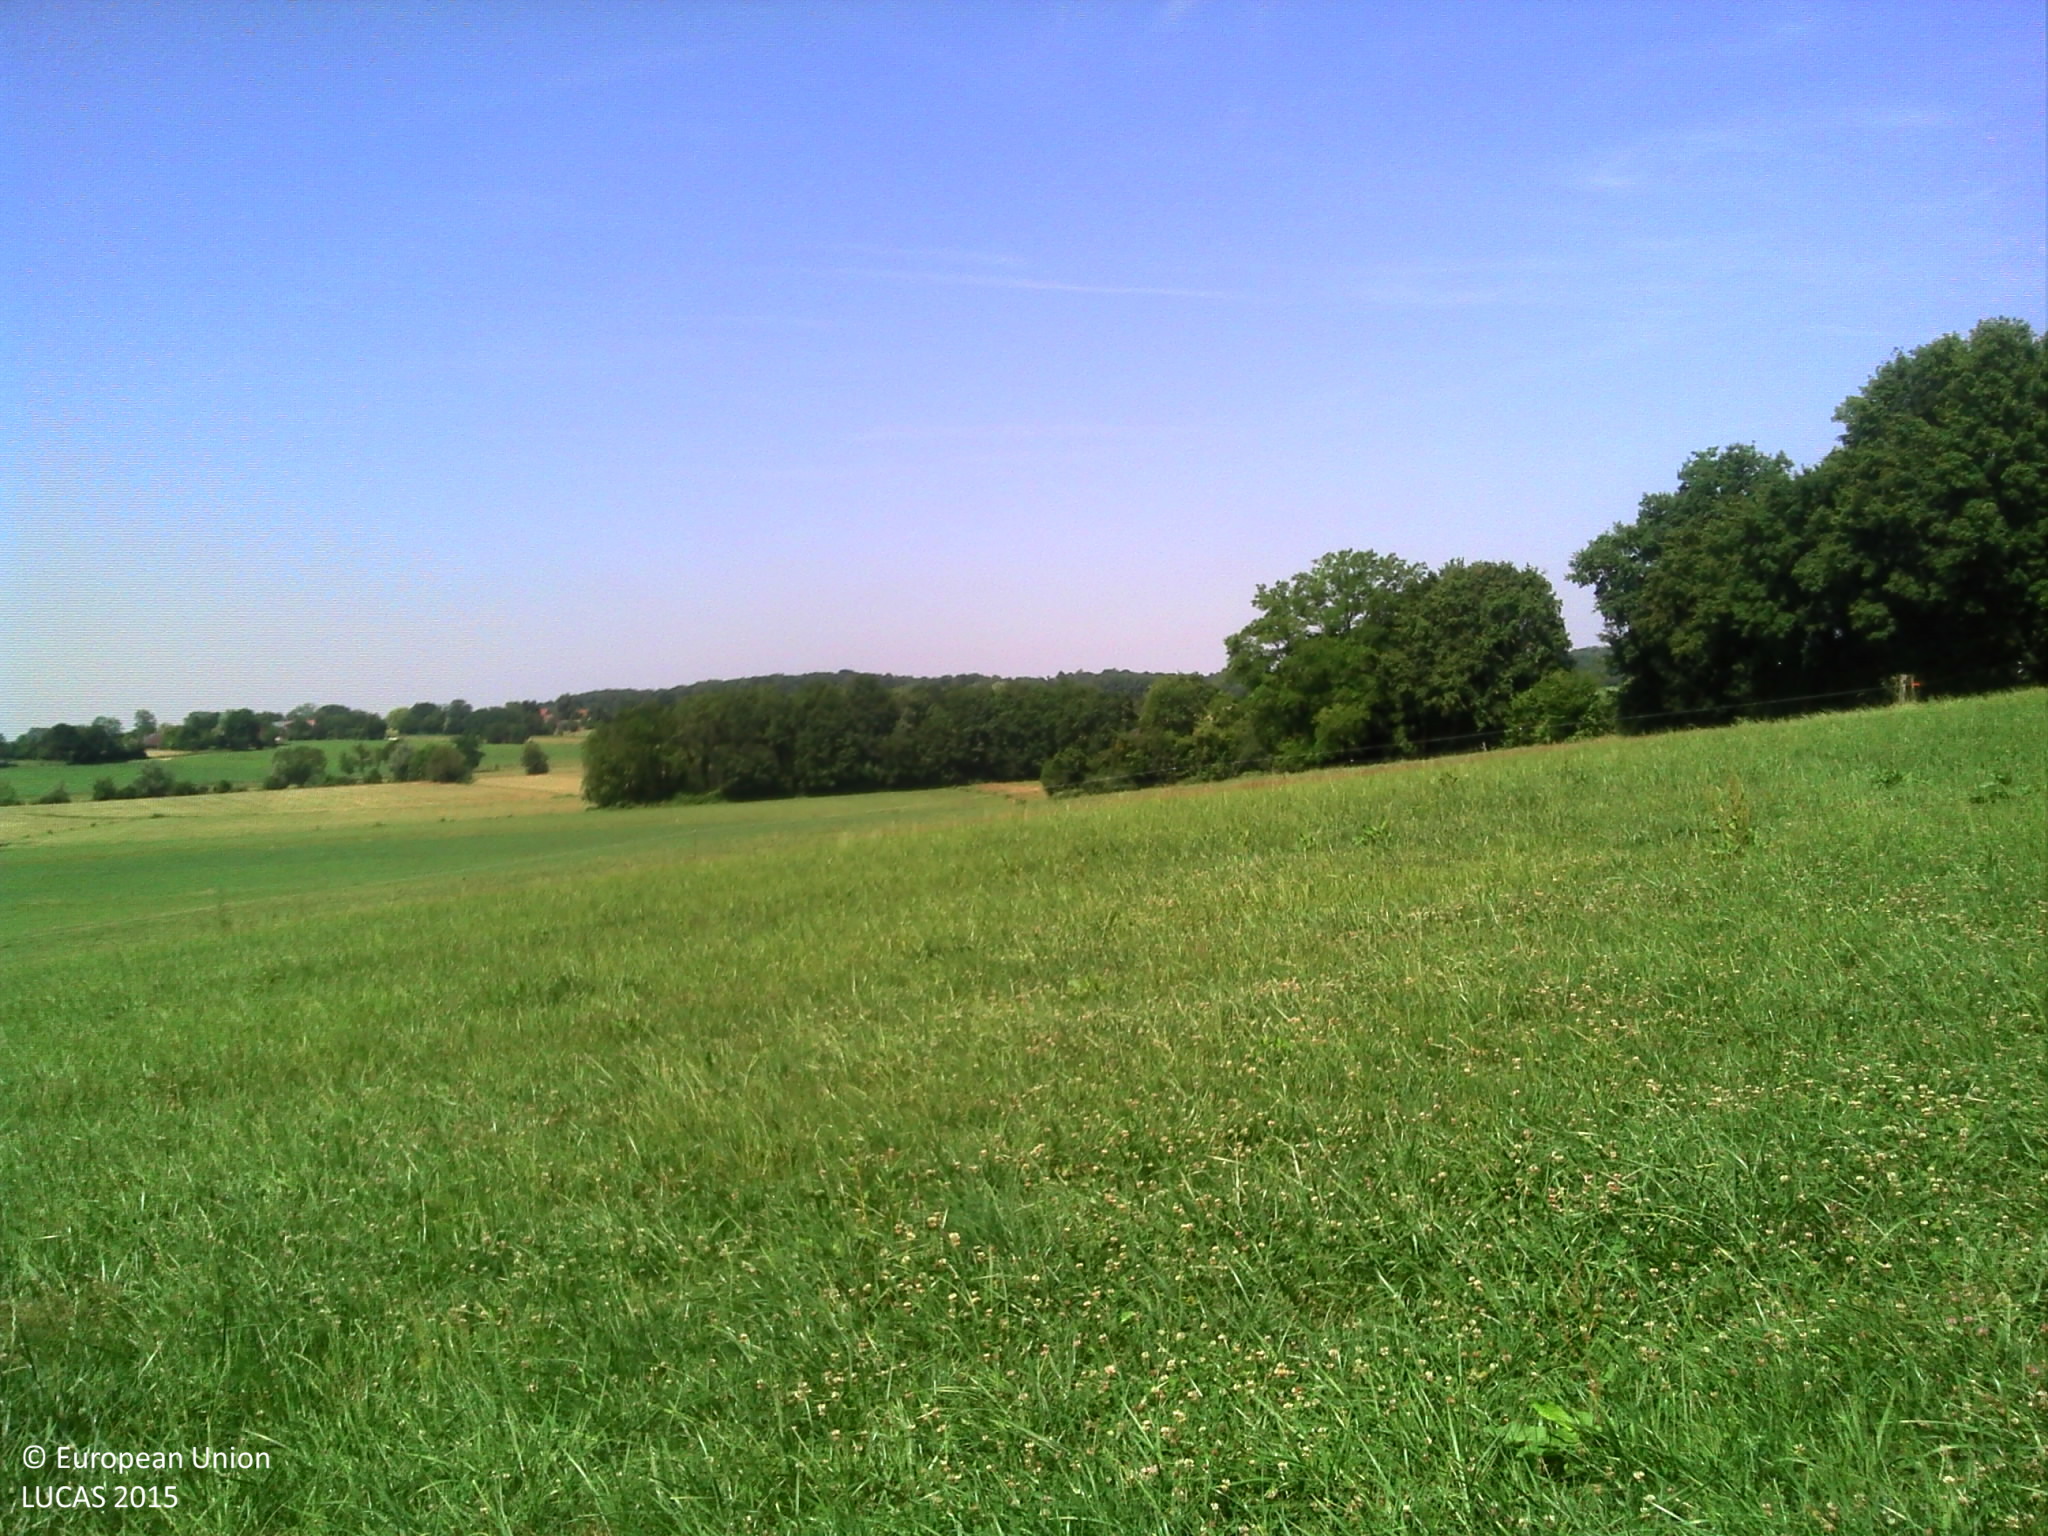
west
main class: Cropland
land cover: Clovers
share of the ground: > 75 %
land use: Agriculture (excluding fallow land and kitchen gardens)
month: June
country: FR
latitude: 46.7902
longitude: 5.3252
